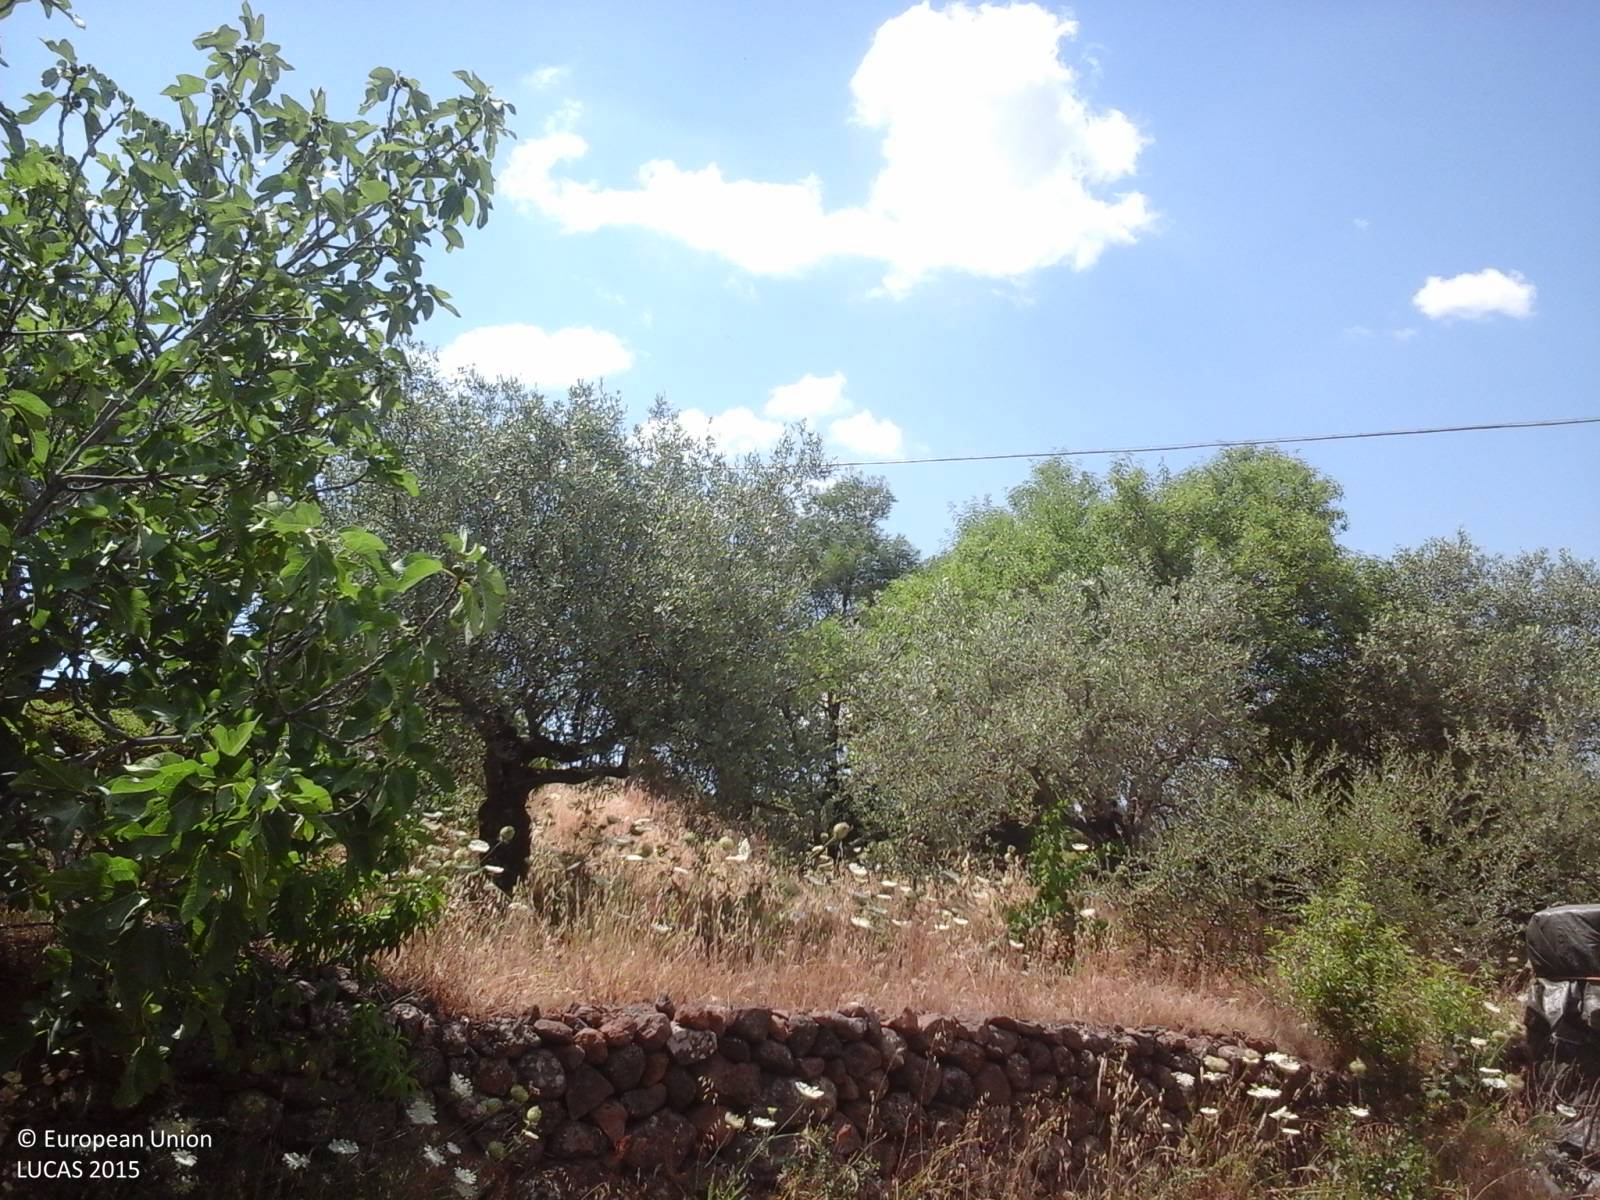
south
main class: Cropland
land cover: Olive groves
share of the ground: > 75 %
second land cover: Spontaneously vegetated surfaces
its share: > 75 %
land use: Agriculture (excluding fallow land and kitchen gardens)
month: June
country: IT
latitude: 40.3026
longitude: 9.5670
